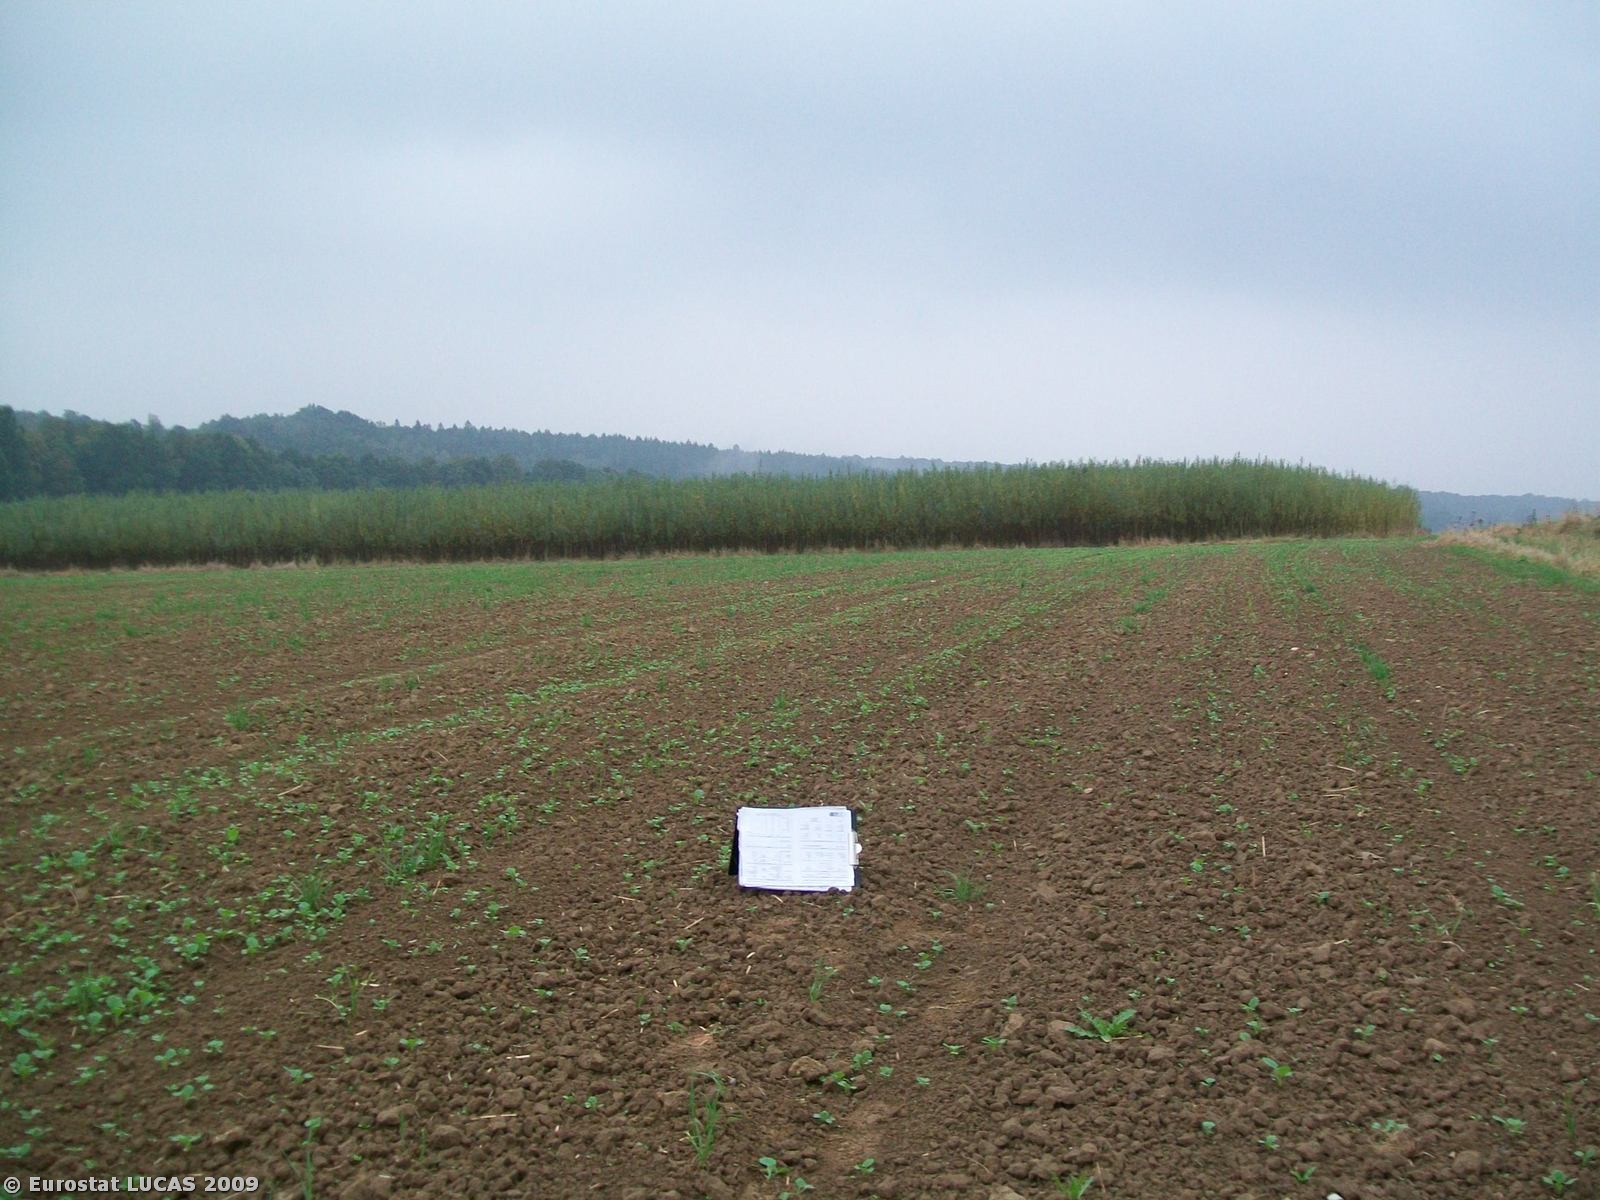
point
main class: Cropland
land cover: Common wheat
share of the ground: < 10 %
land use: Agriculture (excluding fallow land and kitchen gardens)
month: September
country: PL
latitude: 50.3881
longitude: 17.2265
